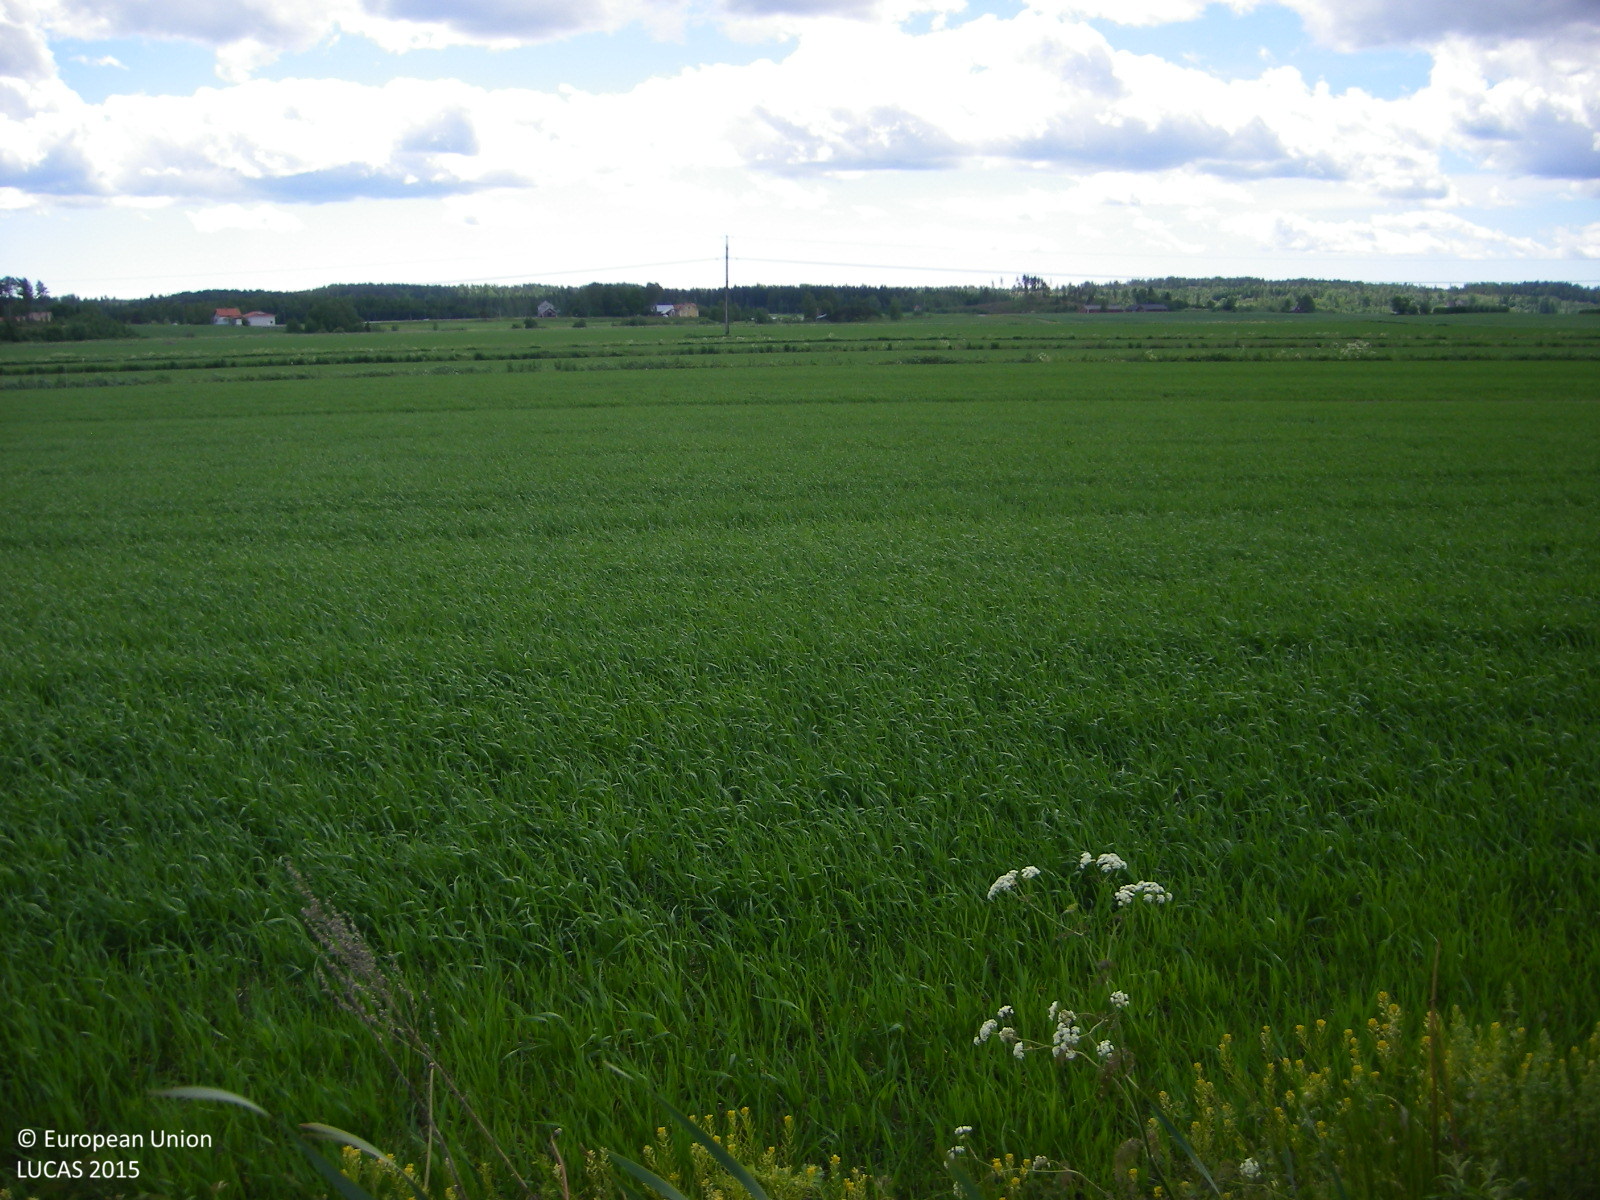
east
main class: Cropland
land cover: Common wheat
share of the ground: > 75 %
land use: Agriculture (excluding fallow land and kitchen gardens)
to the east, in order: Common wheat
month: June
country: FI
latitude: 60.1850
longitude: 24.0737
